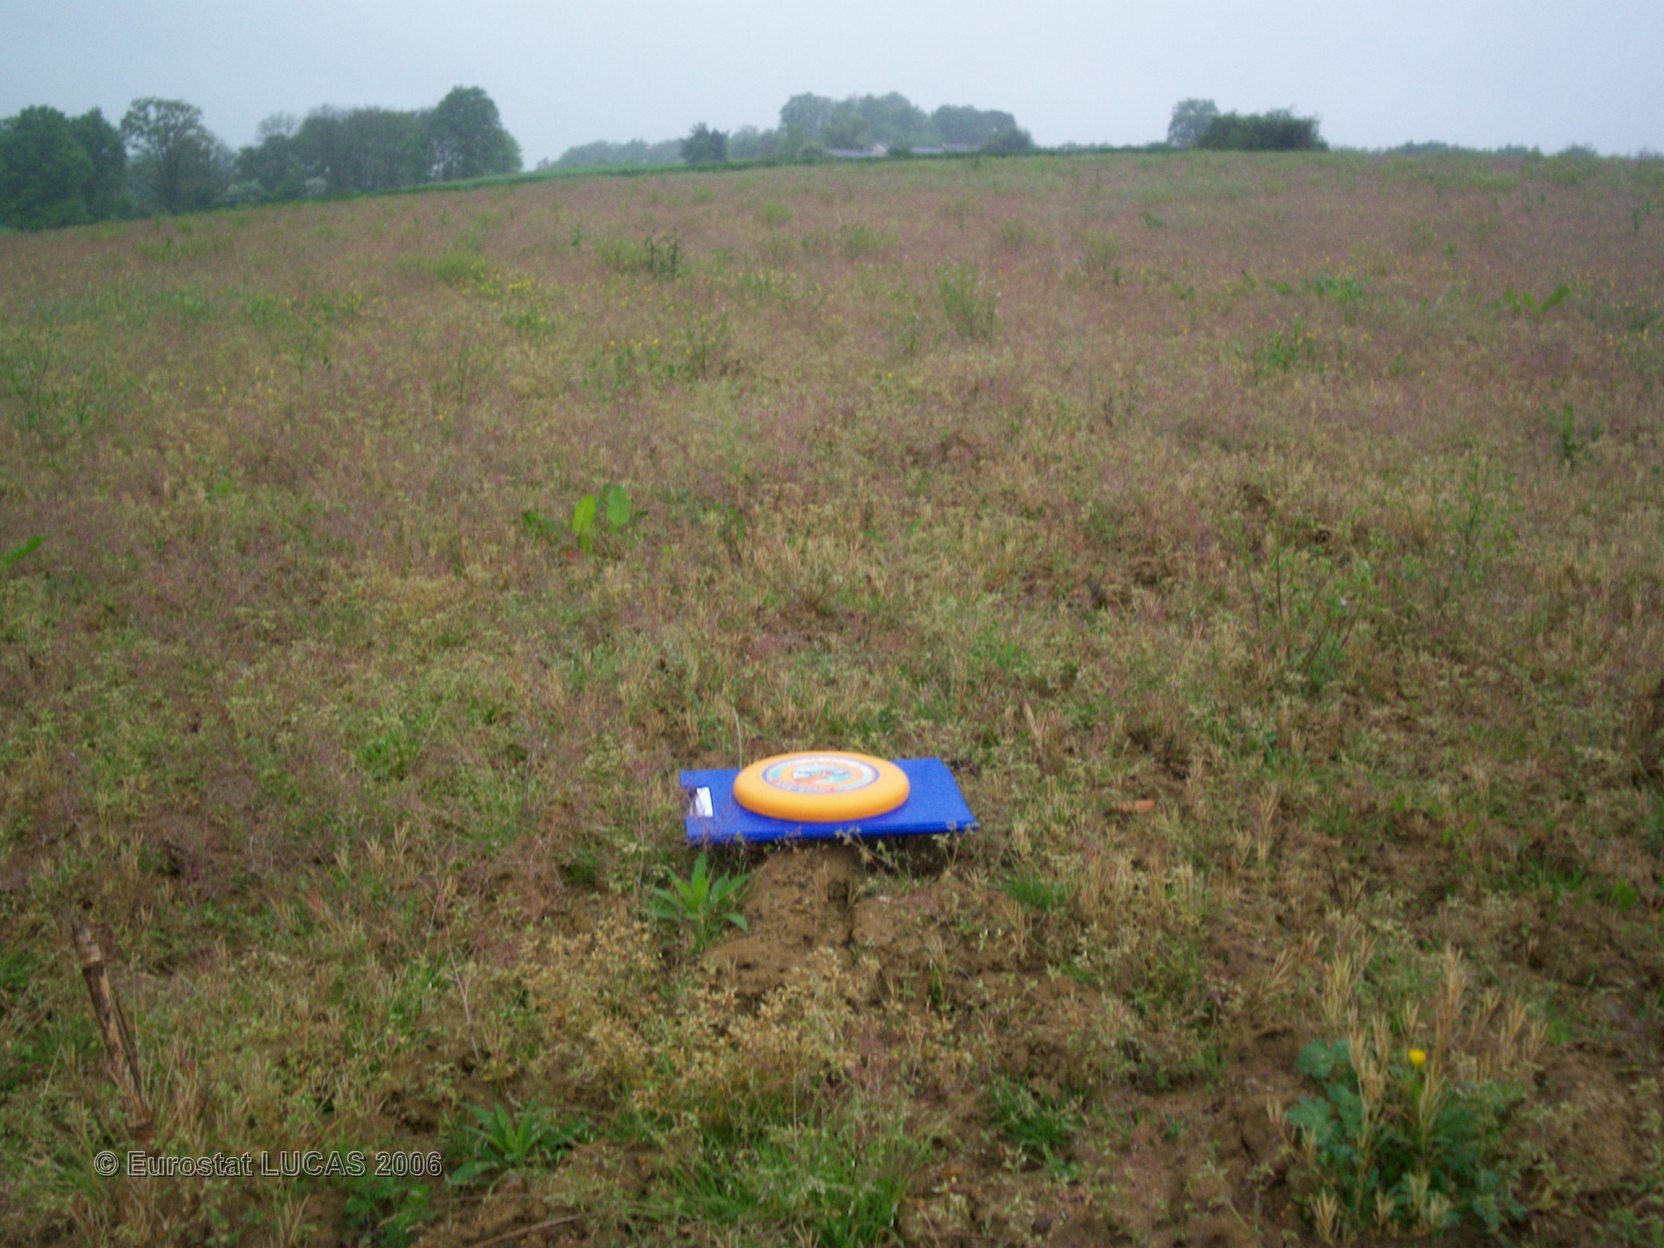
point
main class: Grassland
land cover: Grassland without tree/shrub cover
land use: Fallow land
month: April
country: FR
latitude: 43.5952
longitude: -0.3518
